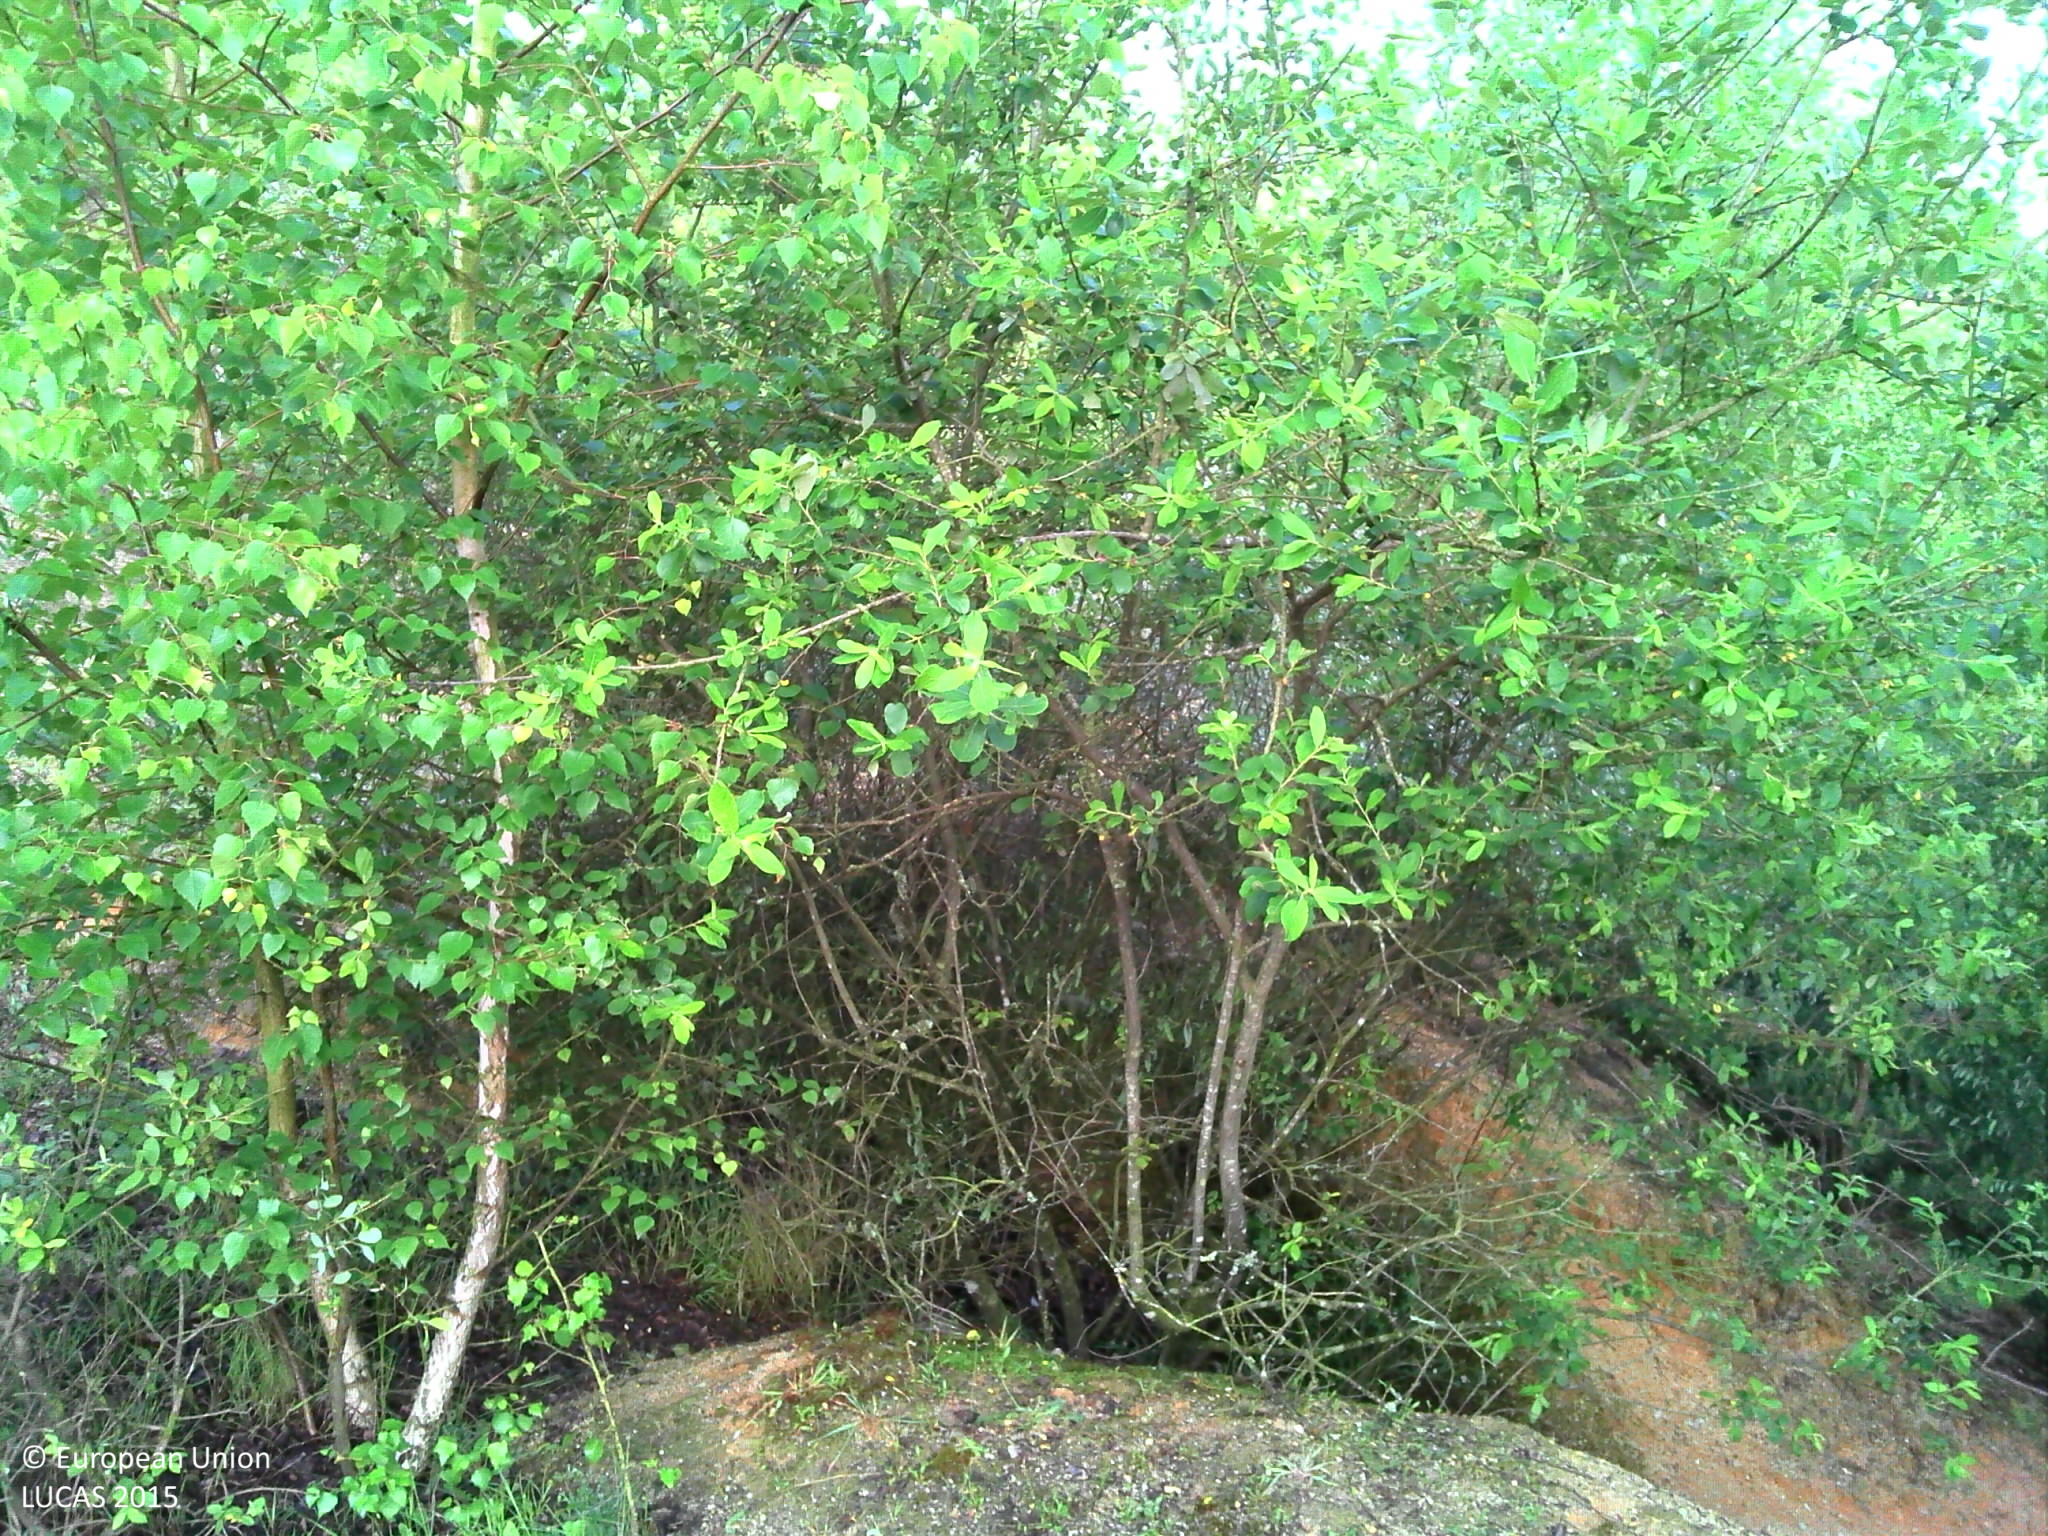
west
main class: Woodland
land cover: Broadleaved woodland
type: exotic forest
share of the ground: > 75 %
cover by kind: broadleaved forest trees 90 %, herbaceous plants 5 %, lichens and mosses 5 %
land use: Forestry
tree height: > 5 m
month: June
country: FR
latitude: 48.2425
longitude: -1.4509
